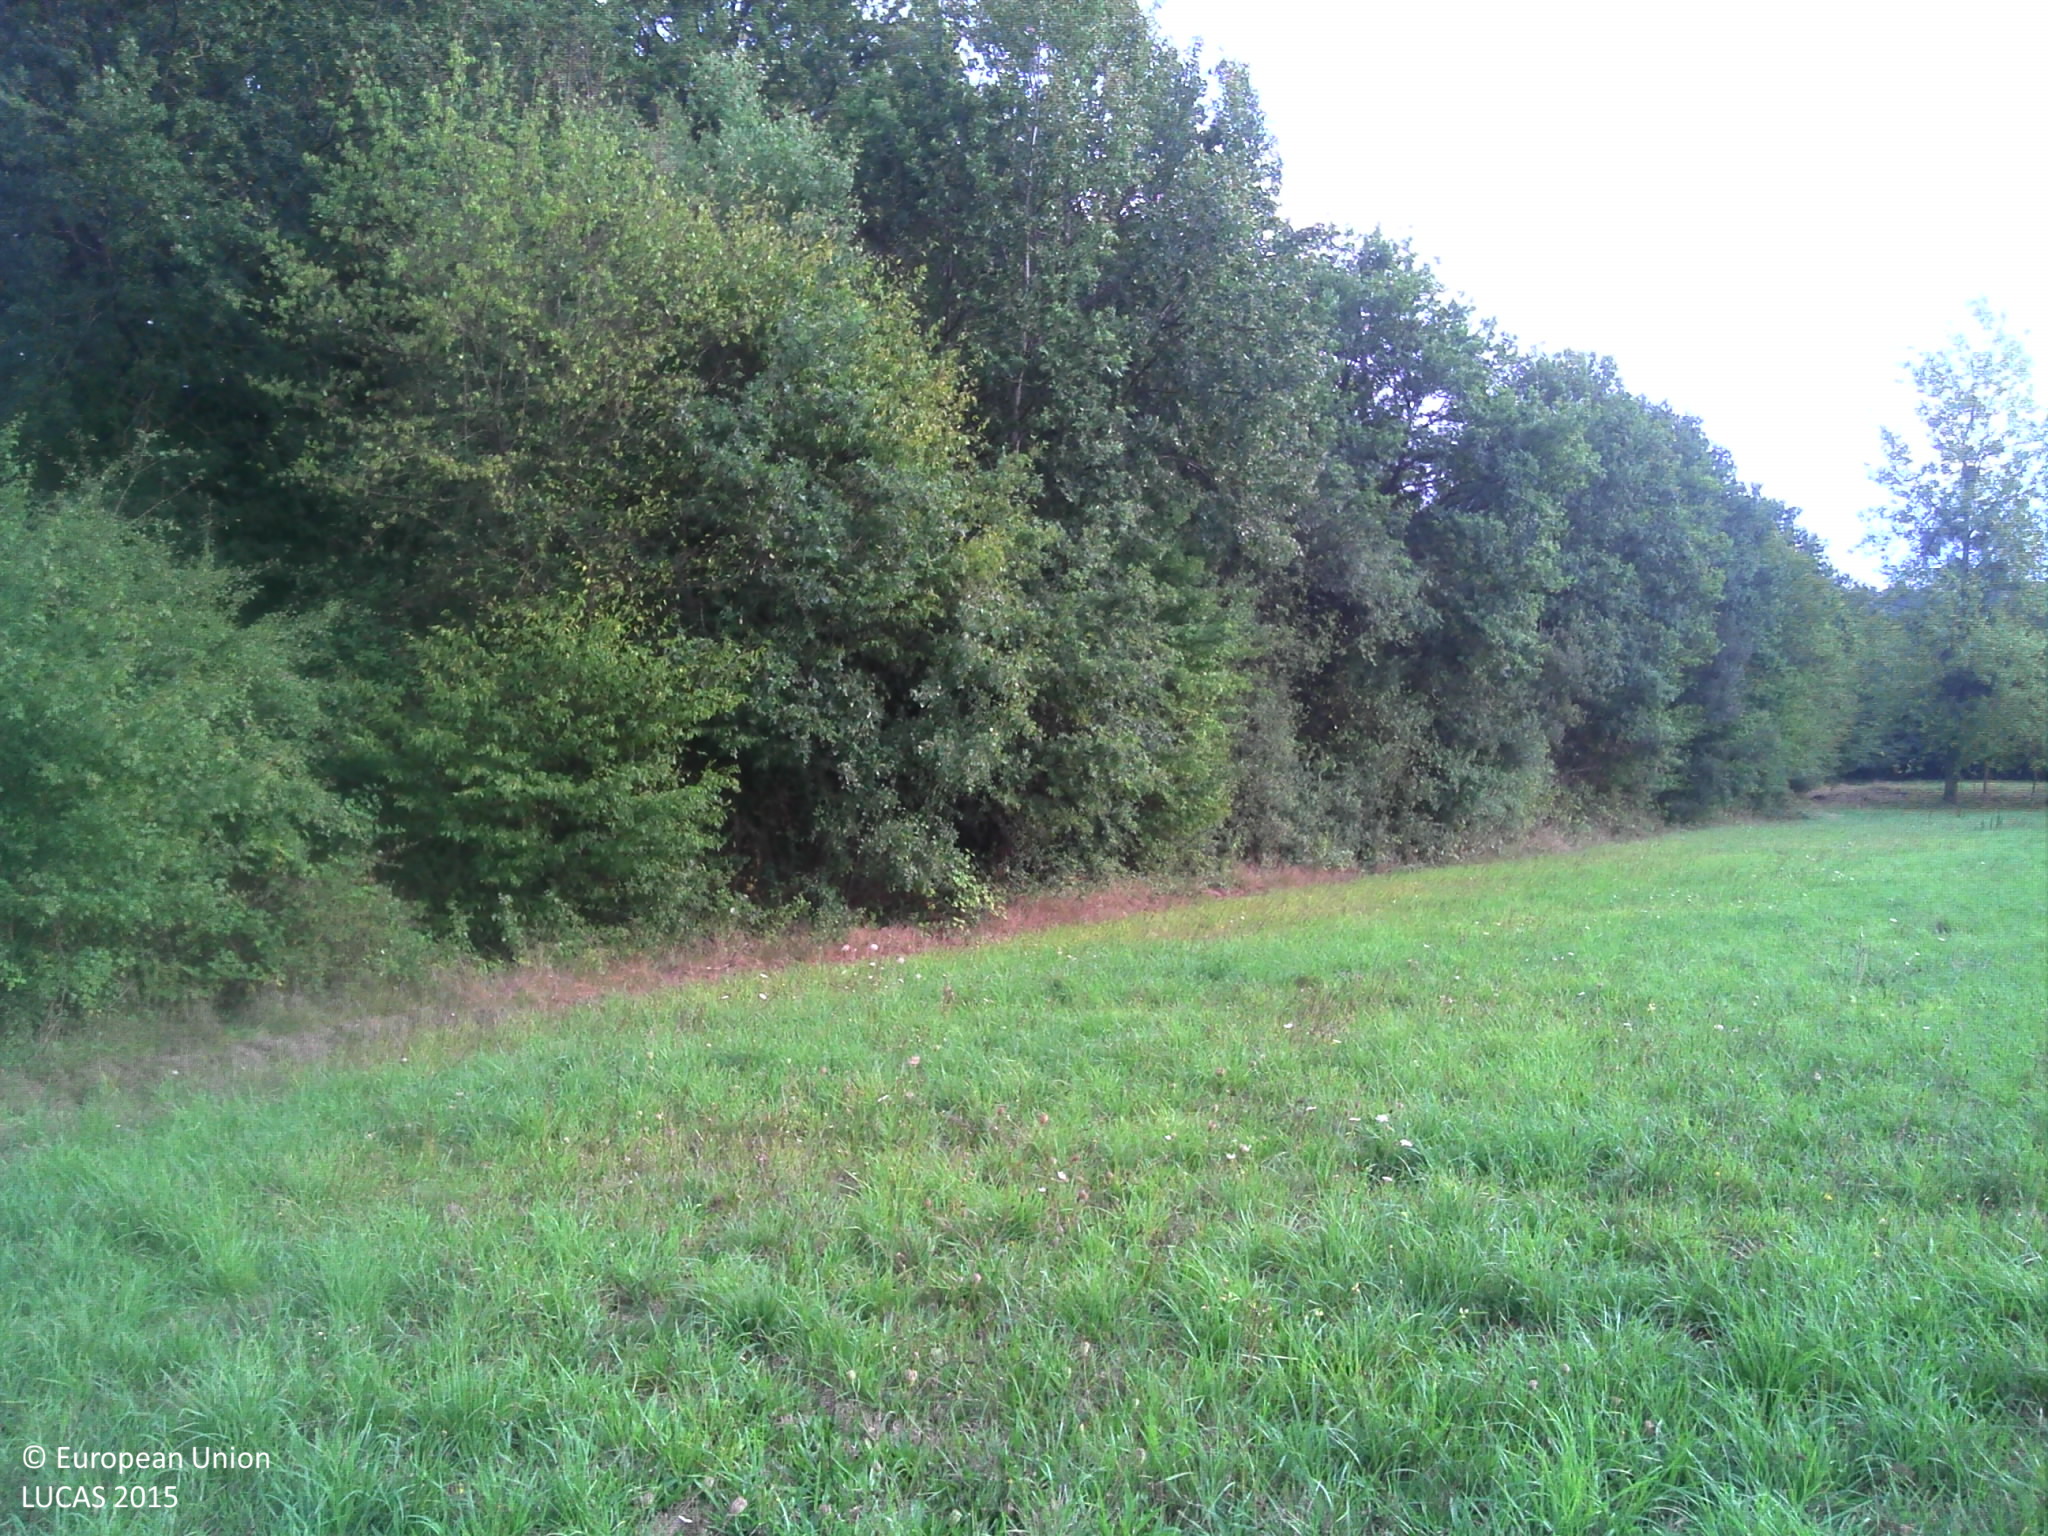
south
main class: Grassland
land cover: Grassland without tree/shrub cover
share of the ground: > 75 %
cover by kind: herbaceous plants 100 %
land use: Agriculture (excluding fallow land and kitchen gardens)
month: September
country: FR
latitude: 48.4201
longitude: 0.8303
